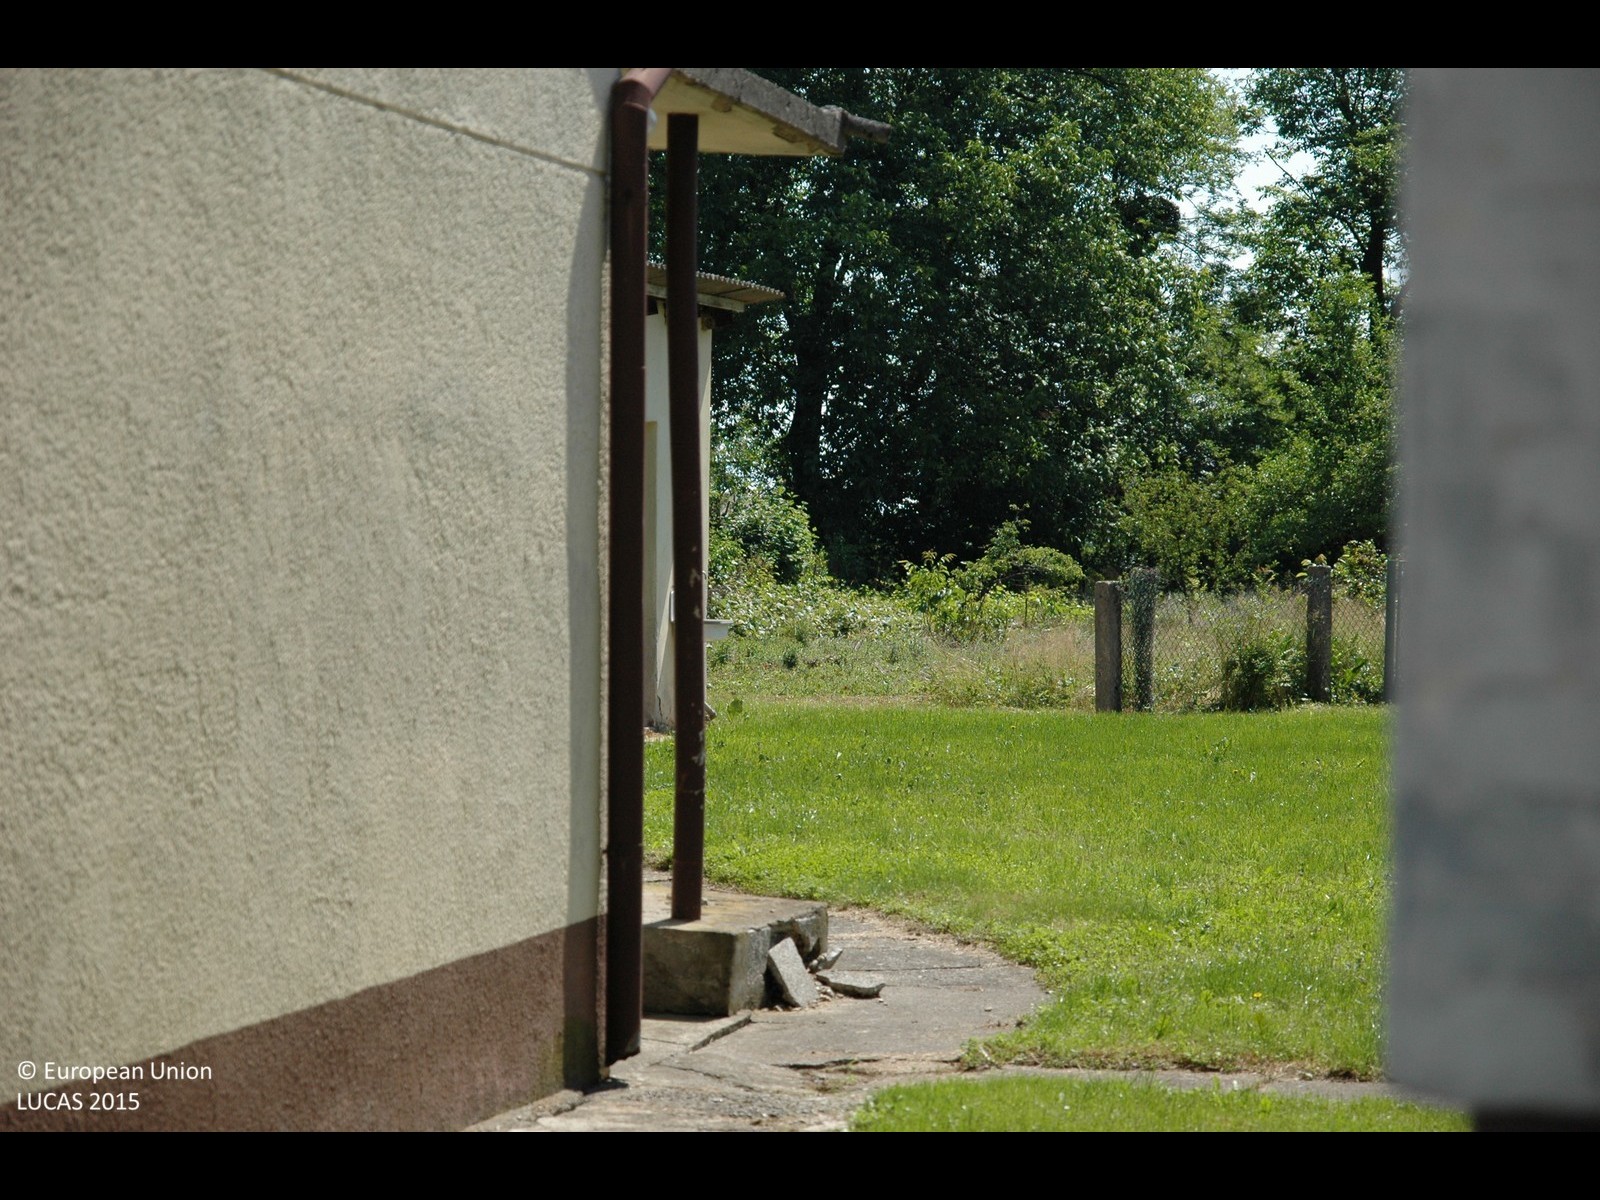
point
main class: Grassland
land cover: Grassland without tree/shrub cover
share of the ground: > 75 %
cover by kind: herbaceous plants 100 %
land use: Residential
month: May
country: HR
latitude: 46.5207
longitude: 16.4012
